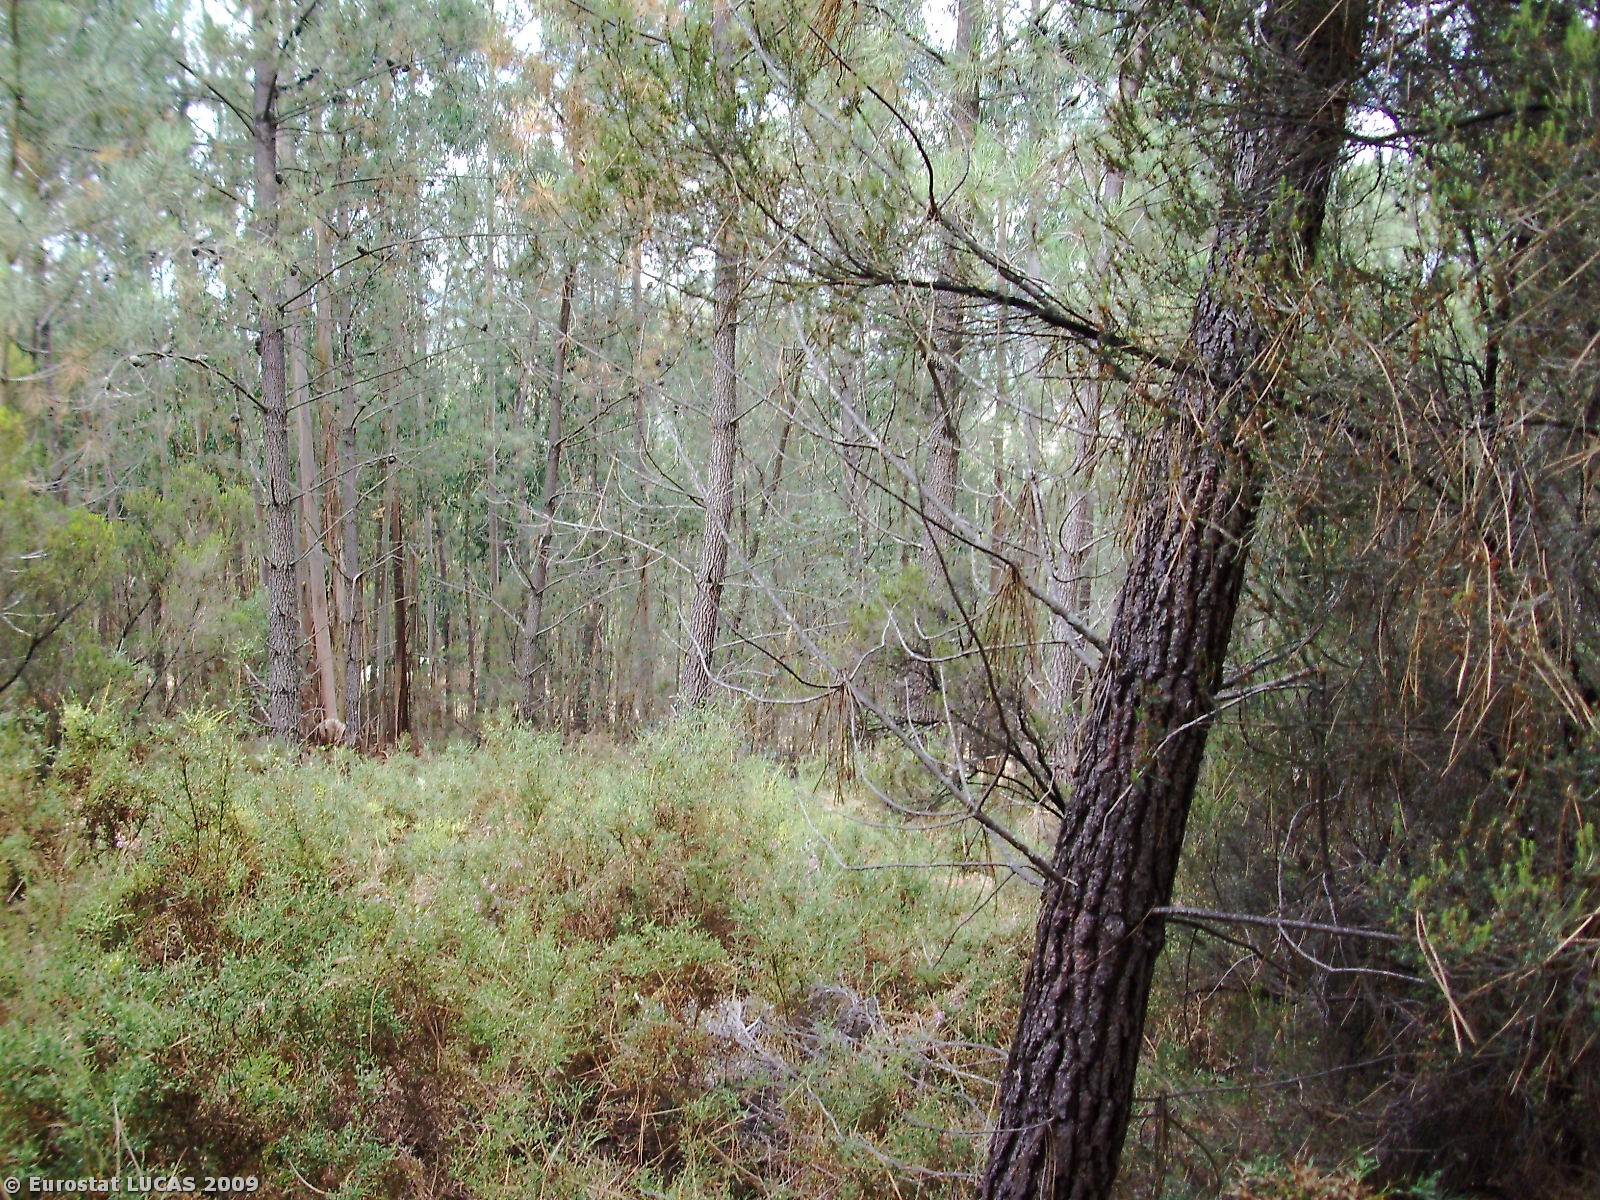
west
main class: Woodland
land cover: Coniferous woodland
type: coniferous forest of the mediterranean region
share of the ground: > 75 %
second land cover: Shrubland with sparse tree cover
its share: 10 - 25 %
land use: Forestry
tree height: > 5 m
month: August
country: PT
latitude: 40.1109
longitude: -8.3467
